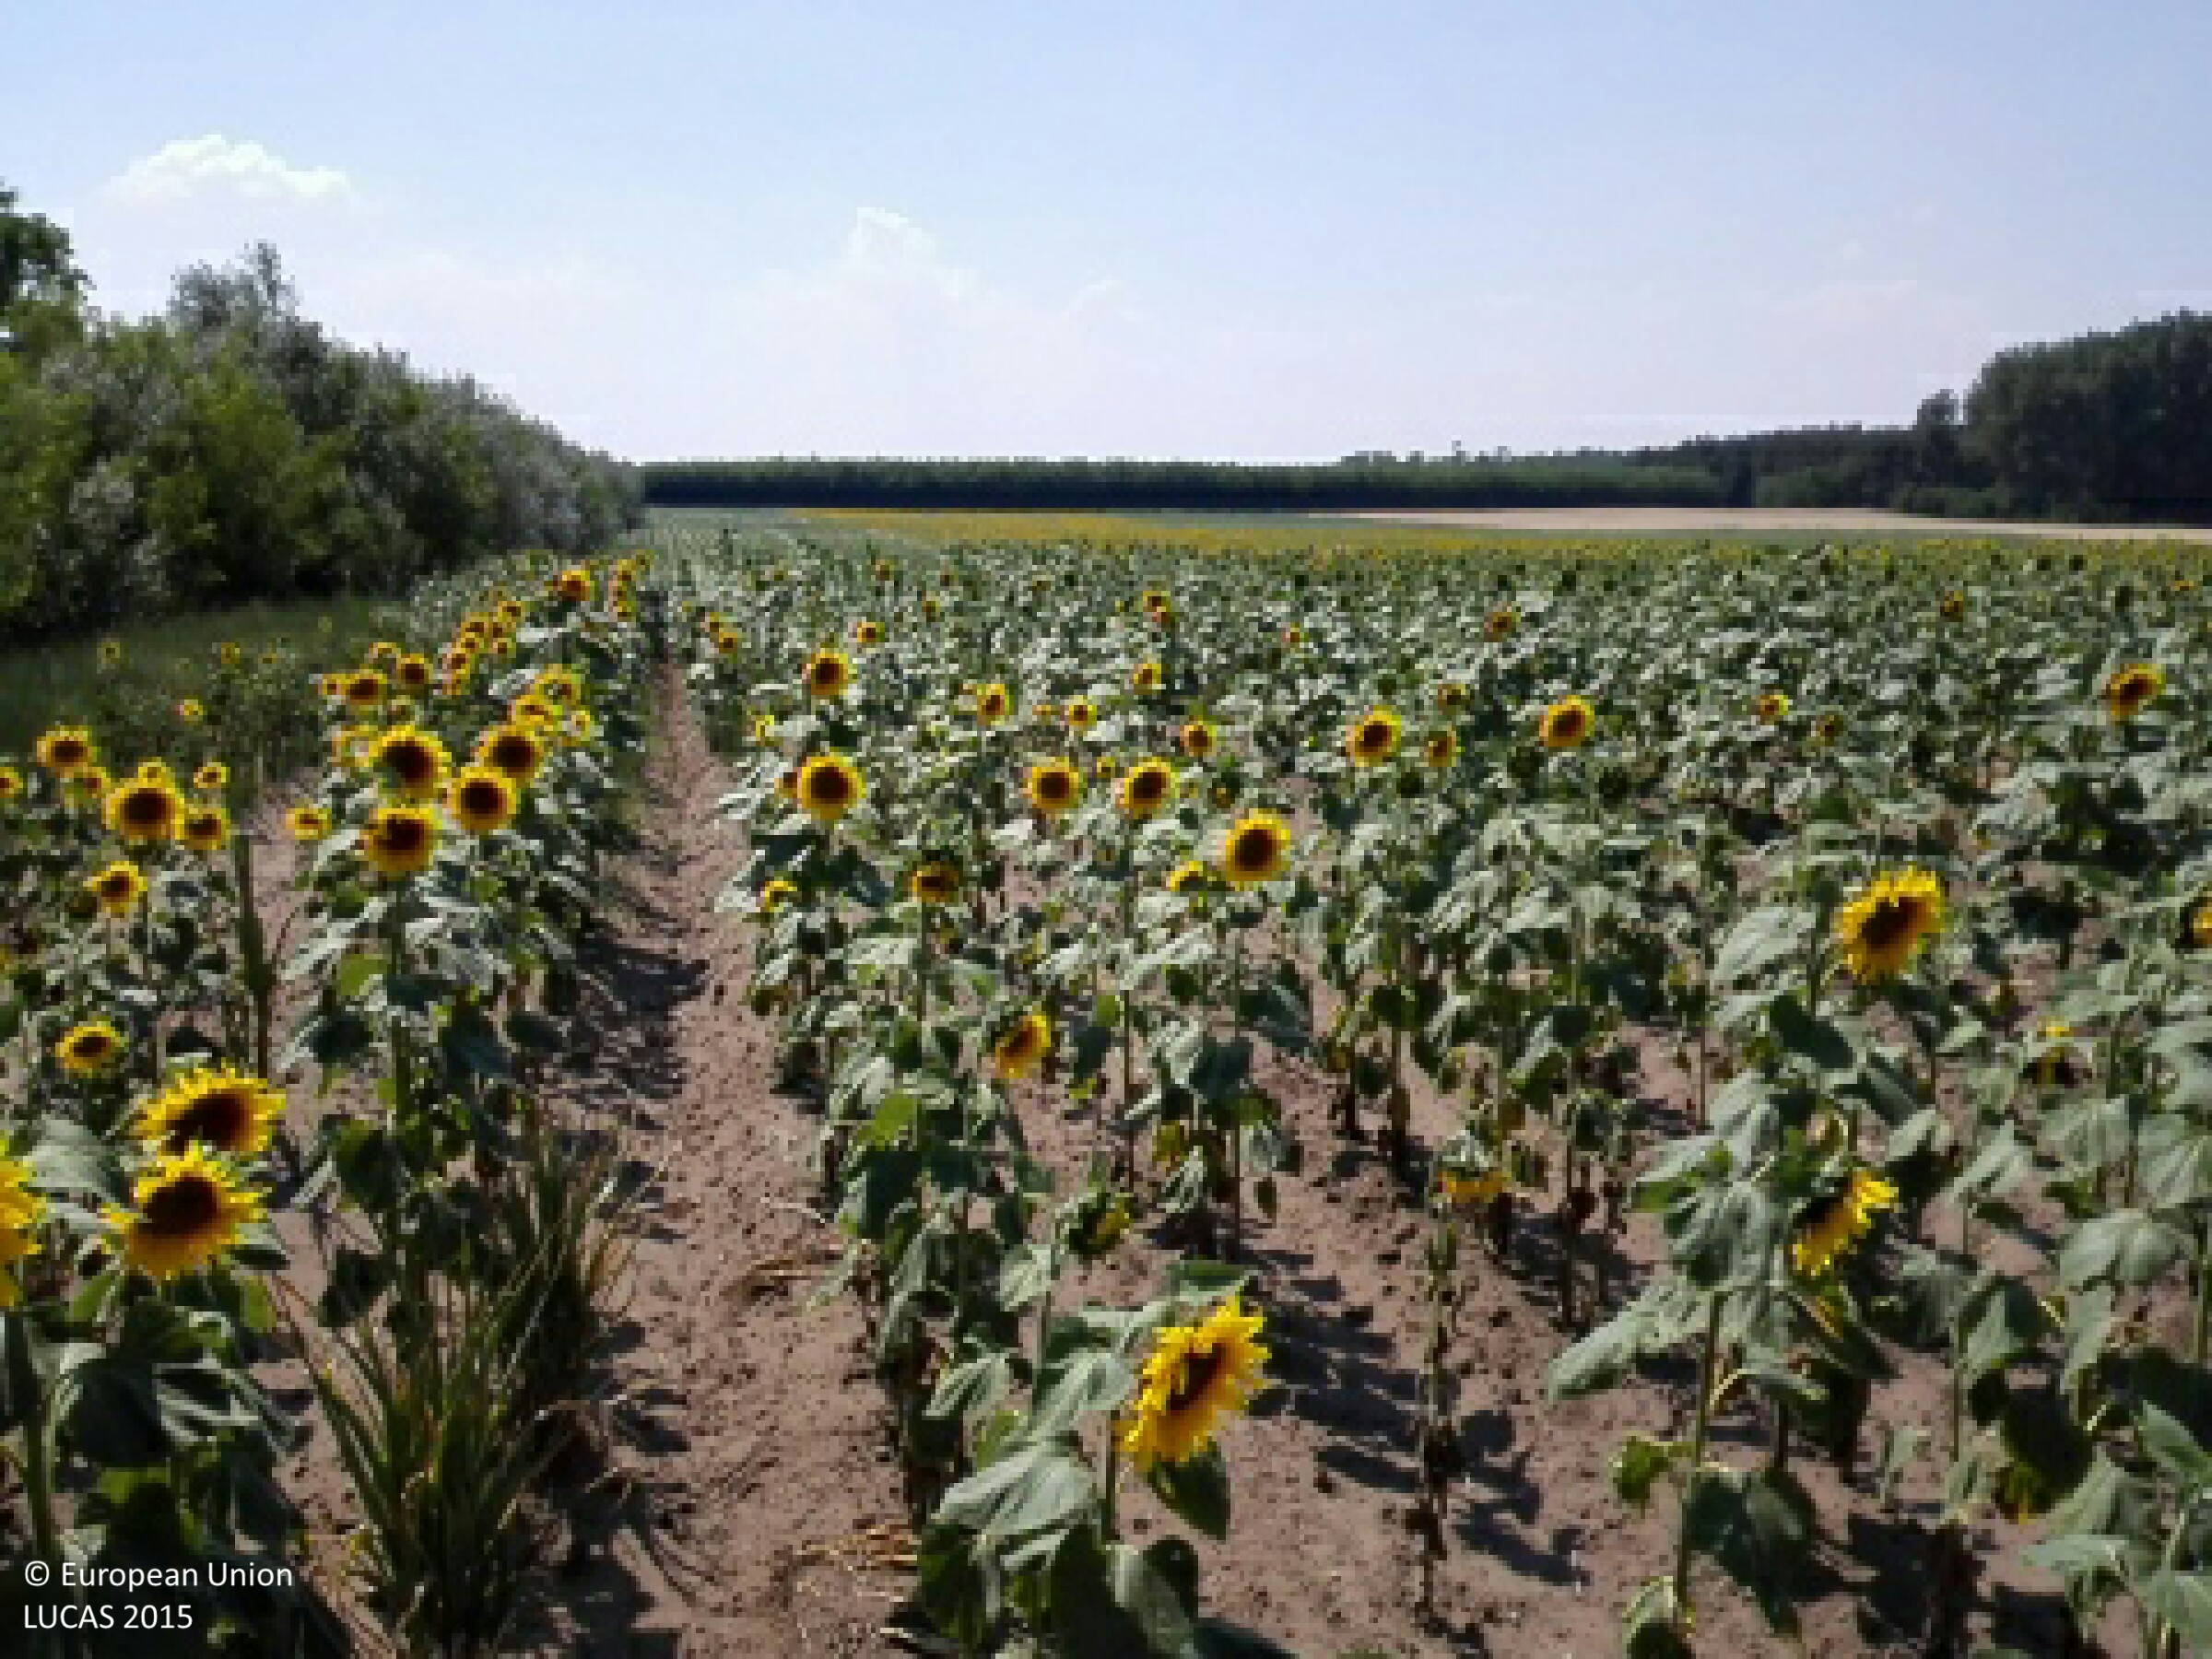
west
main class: Cropland
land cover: Sunflower
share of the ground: 10 - 25 %
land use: Agriculture (excluding fallow land and kitchen gardens)
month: July
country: HU
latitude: 47.6354
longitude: 21.6917
